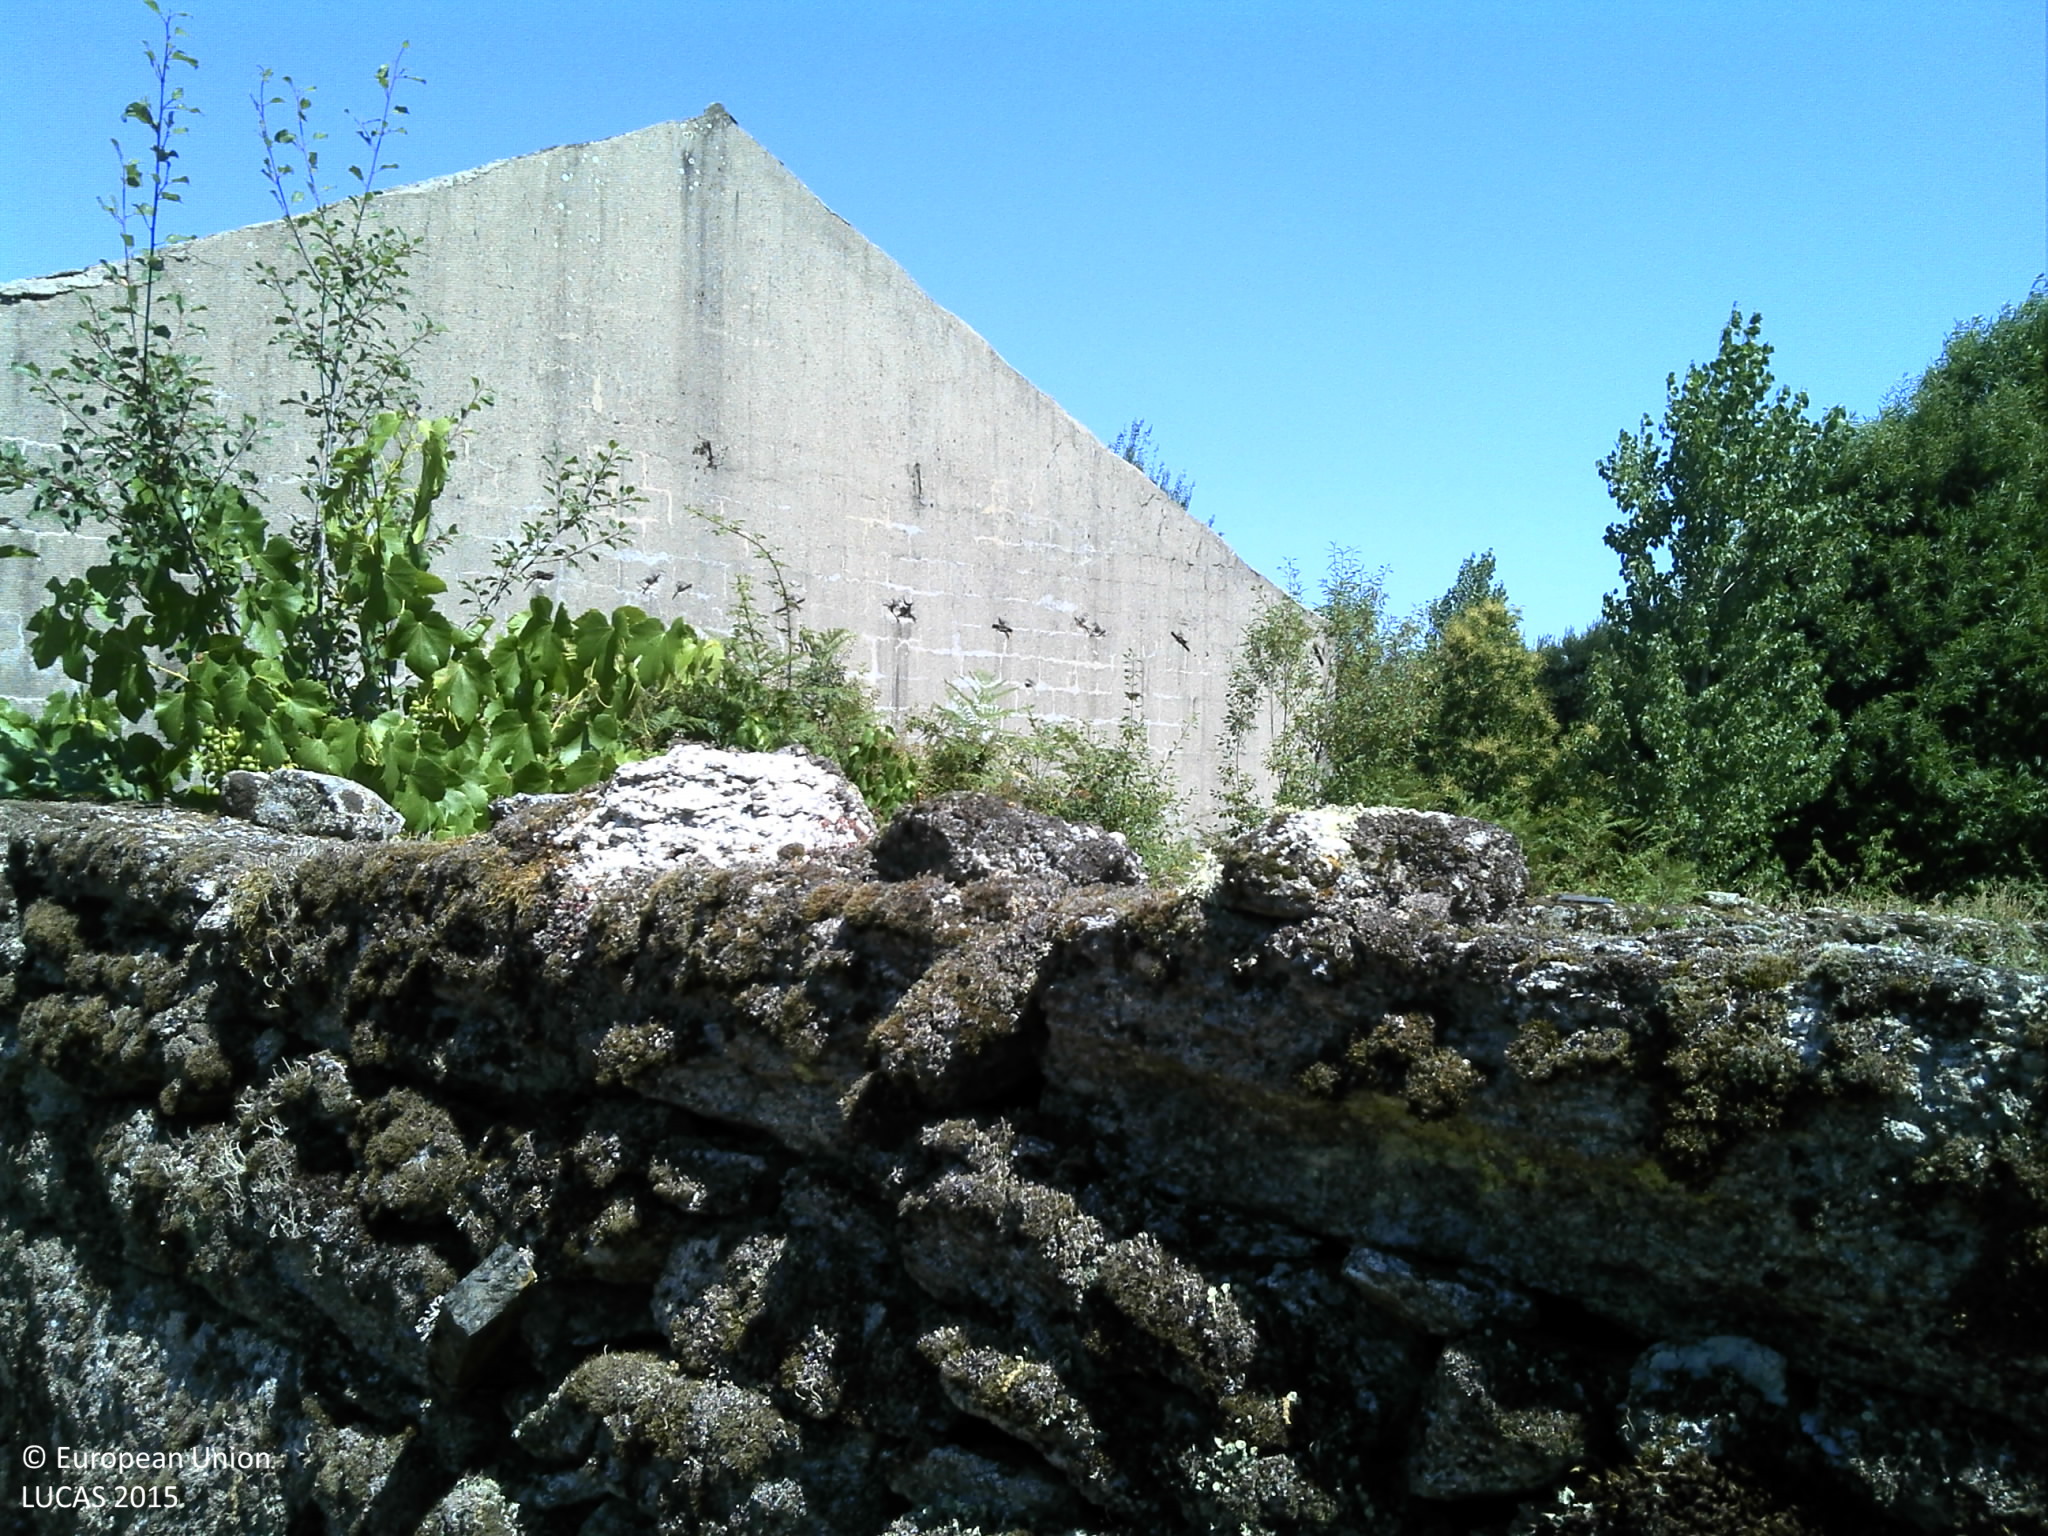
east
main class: Grassland
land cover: Grassland without tree/shrub cover
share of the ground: > 75 %
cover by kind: herbaceous plants 75 %, unconsolidated bare surface 20 %, shrubs 5 %
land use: Abandoned areas
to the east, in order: Tracks; Dry stone walls; Grassland without tree/shrub cover; Artificial constructions in urban areas; Shrubland without tree cover; Nuts trees; Electric lines; Abandoned hedges; Dry stone walls; Grassland without tree/shrub cover; Dry stone walls; Electric lines; Nuts trees; Other fruit trees and berries; Artificial constructions in urban areas; Nuts trees; Vineyards; Dry stone walls; Nuts trees; Vineyards; Dry stone walls; Vineyards; Nuts trees; Vineyards; Dry stone walls; Tracks
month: July
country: PT
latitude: 40.8372
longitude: -7.5146
